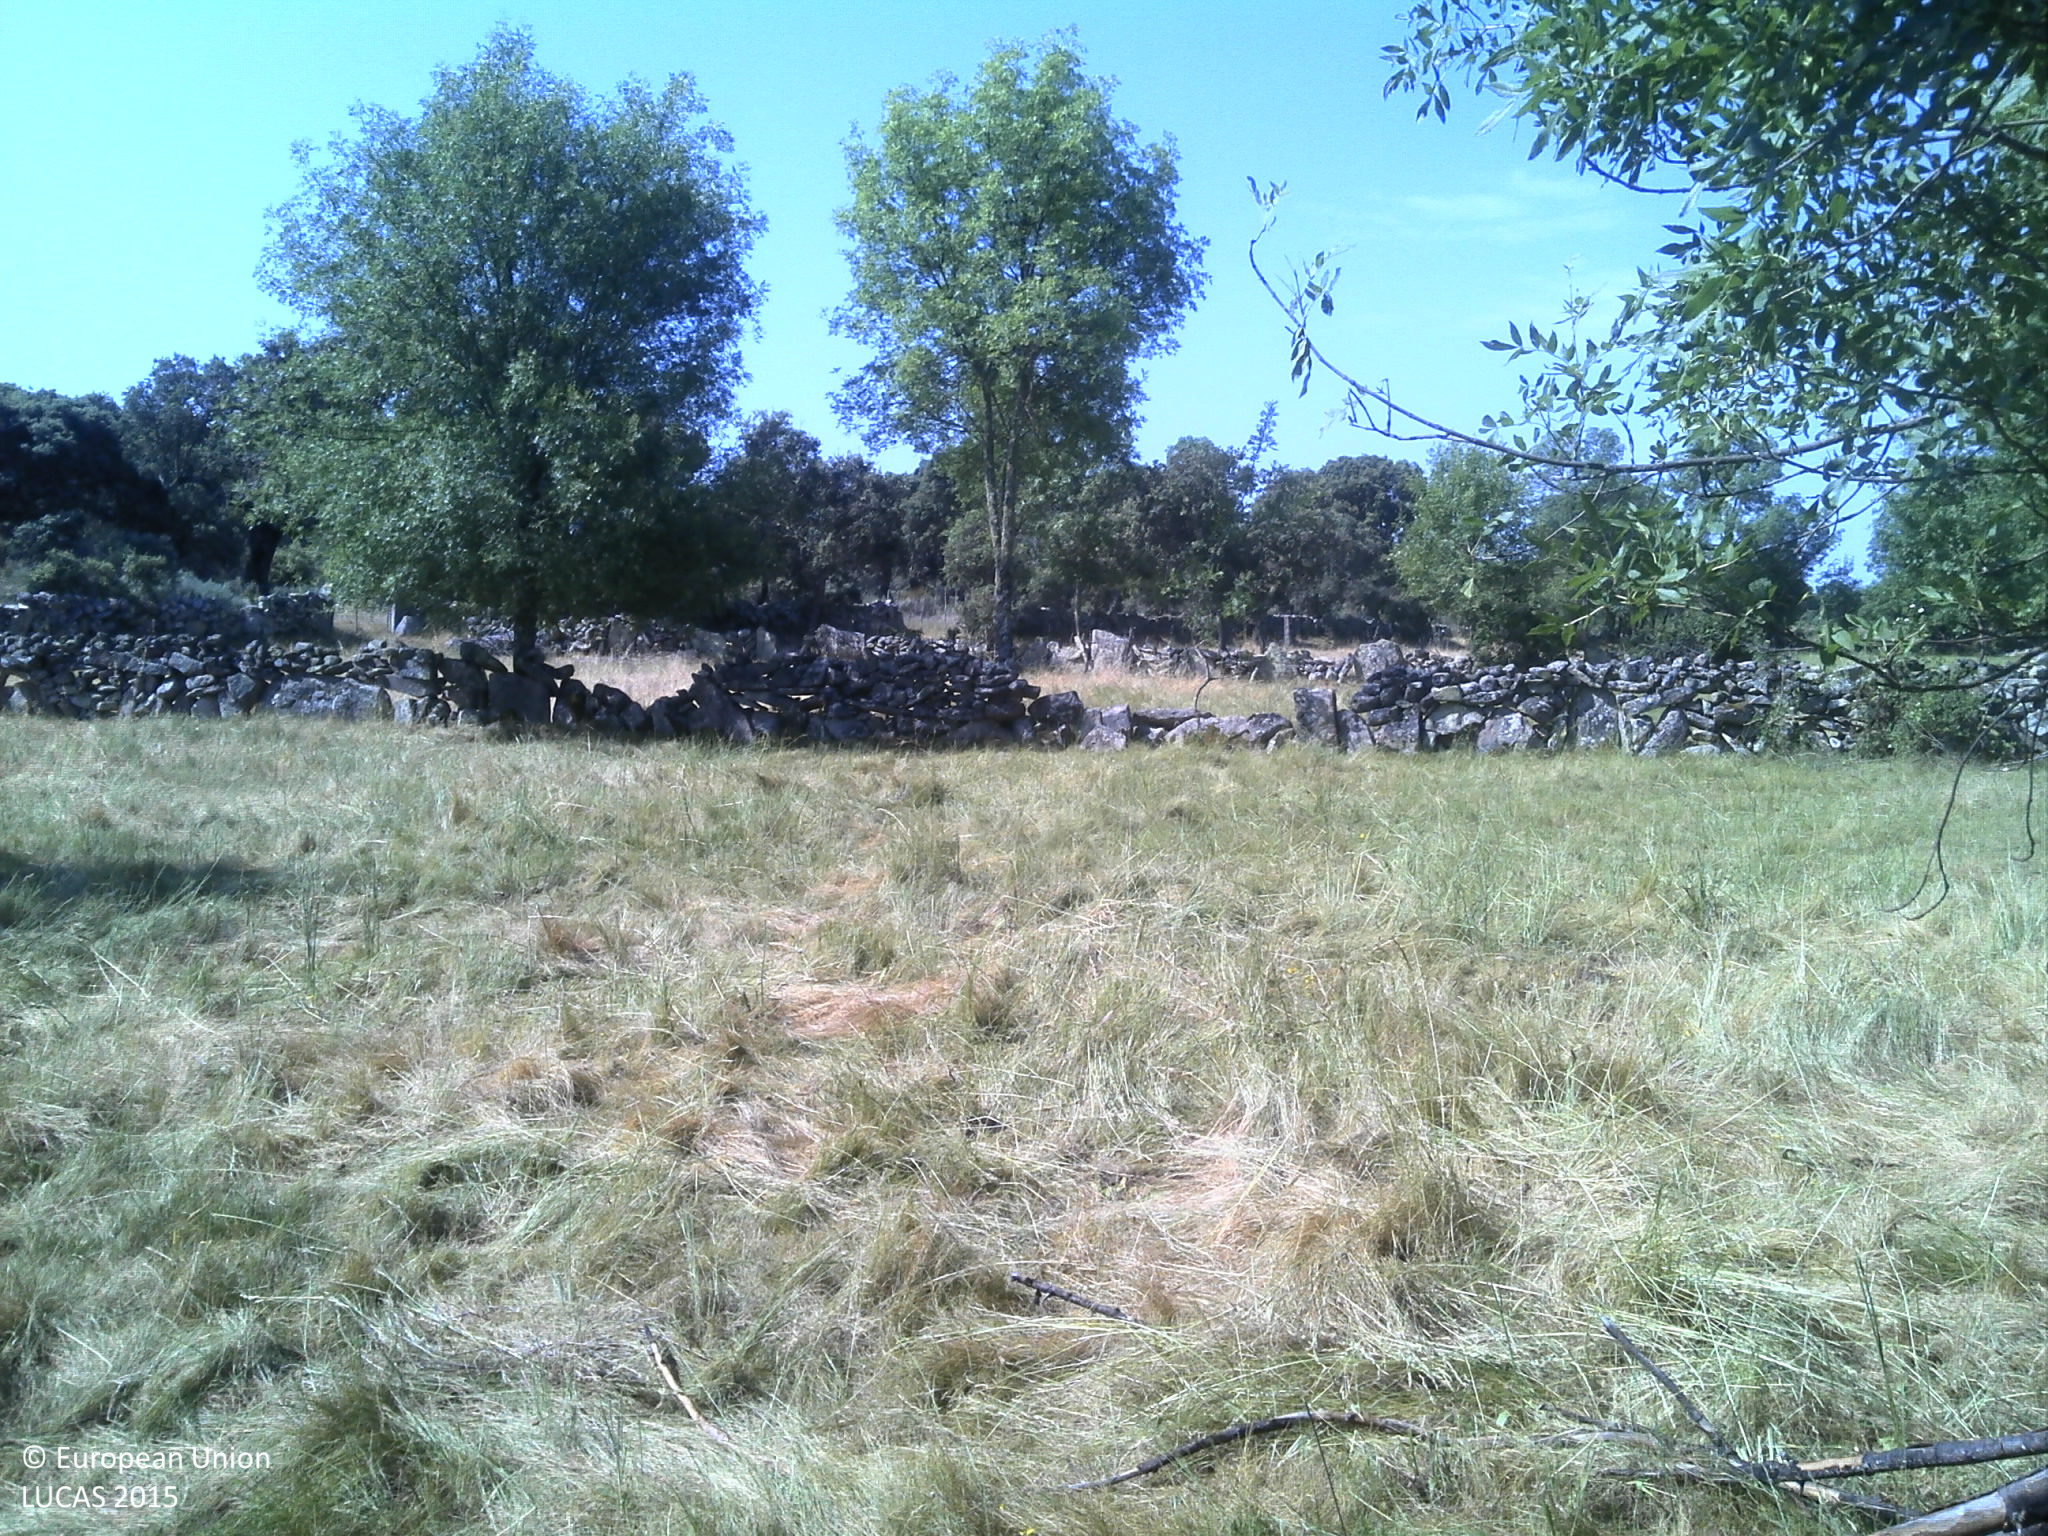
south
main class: Grassland
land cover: Grassland with sparse tree/shrub cover
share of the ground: 50 - 75 %
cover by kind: herbaceous plants 85 %, broadleaved forest trees 5 %, unconsolidated bare surface 5 %
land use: Agriculture (excluding fallow land and kitchen gardens)
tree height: > 5 m
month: June
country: PT
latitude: 40.5526
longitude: -6.8291
